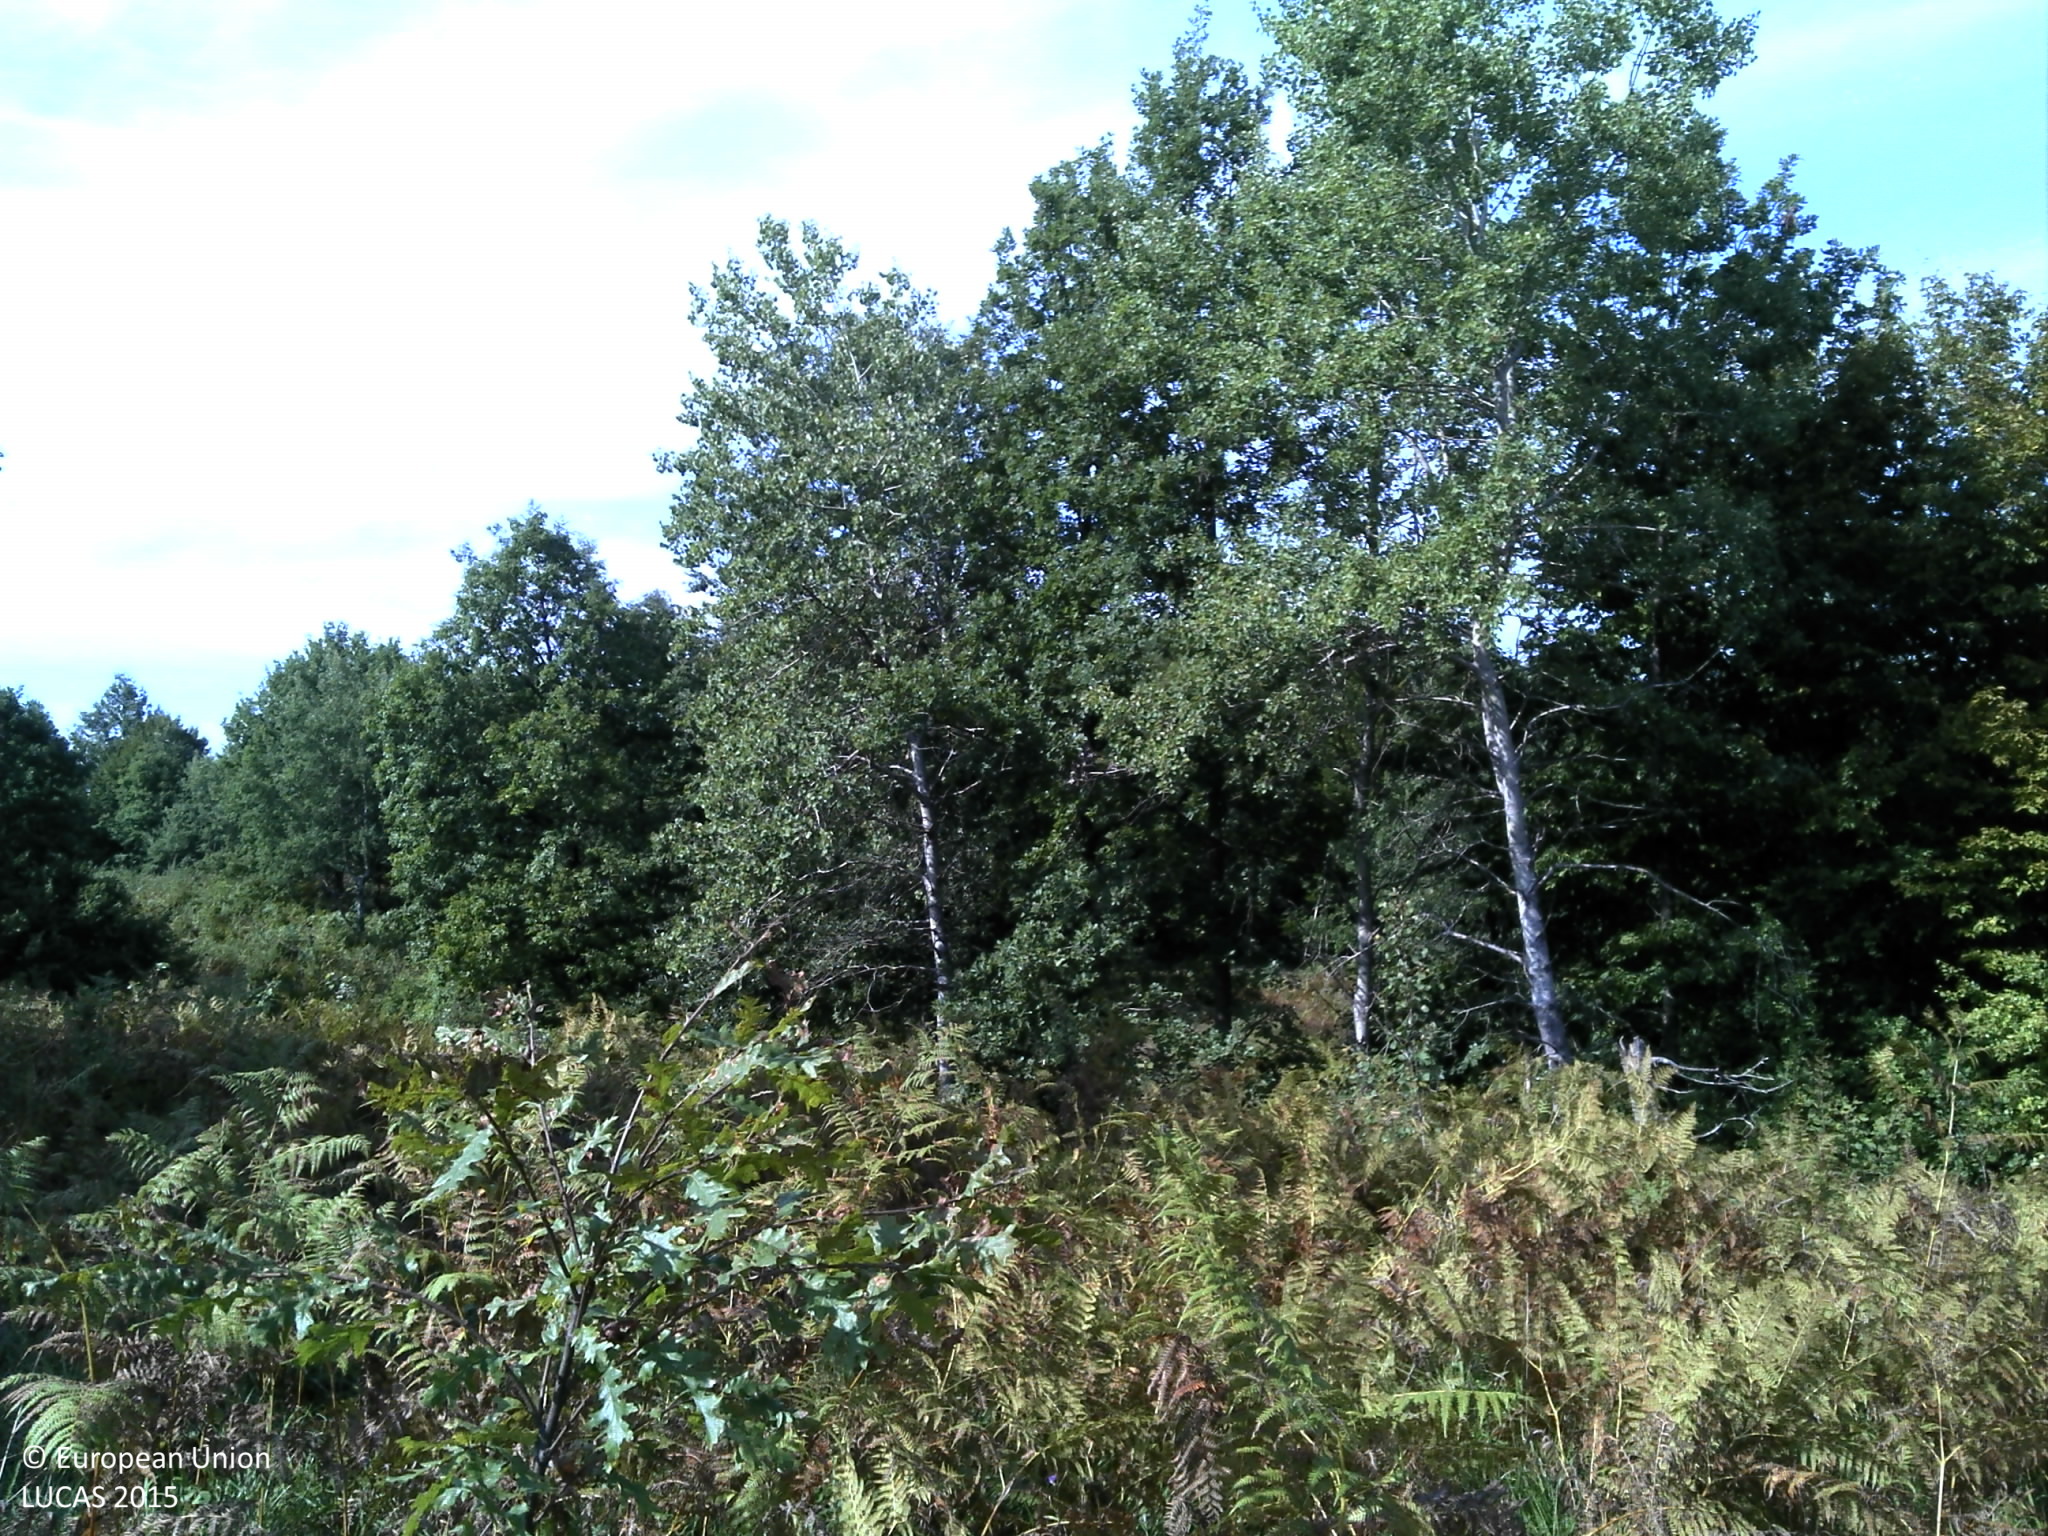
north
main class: Grassland
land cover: Grassland with sparse tree/shrub cover
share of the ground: > 75 %
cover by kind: herbaceous plants 95 %, broadleaved forest trees 5 %
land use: Semi-natural and natural areas not in use
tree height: < 5 m
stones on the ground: < 10 %
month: September
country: HR
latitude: 45.0988
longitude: 15.6757
